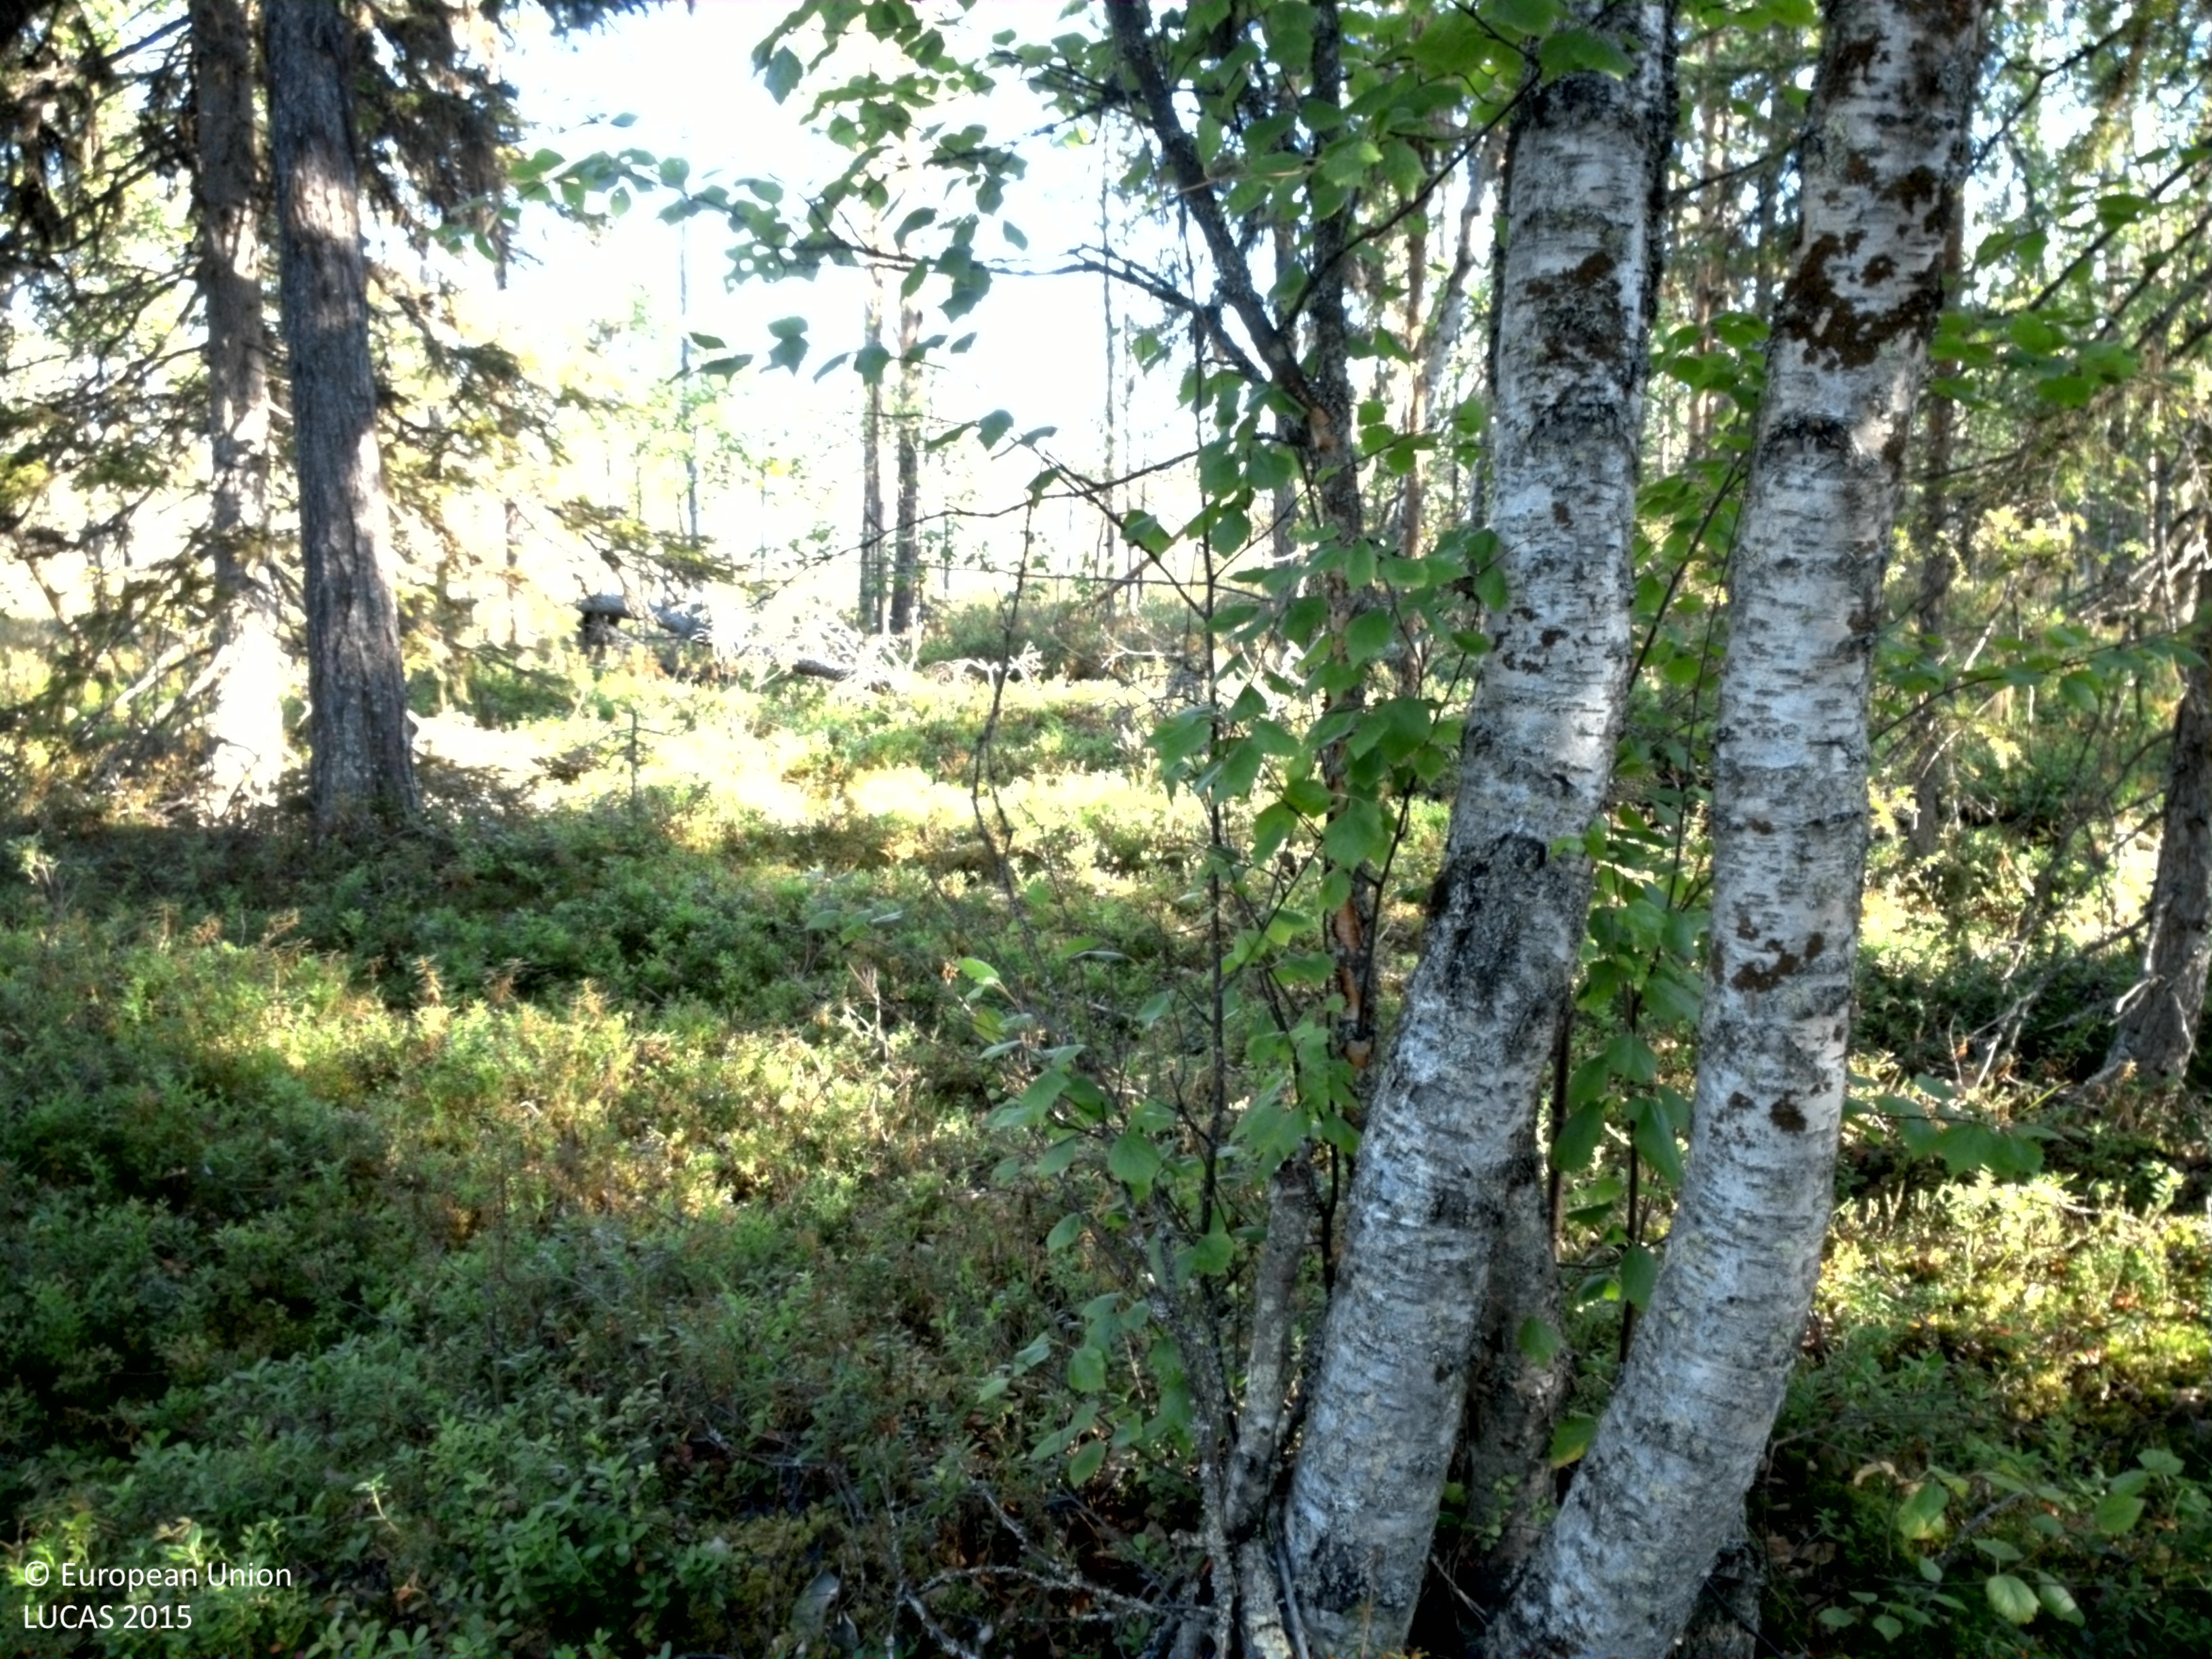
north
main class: Woodland
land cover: Spruce dominated coniferous woodland
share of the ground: 25 - 50 %
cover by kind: shrubs 65 %, coniferous forest trees 30 %, broadleaved forest trees 5 %
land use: Forestry
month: August
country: SE
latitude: 66.6340
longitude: 20.0529
